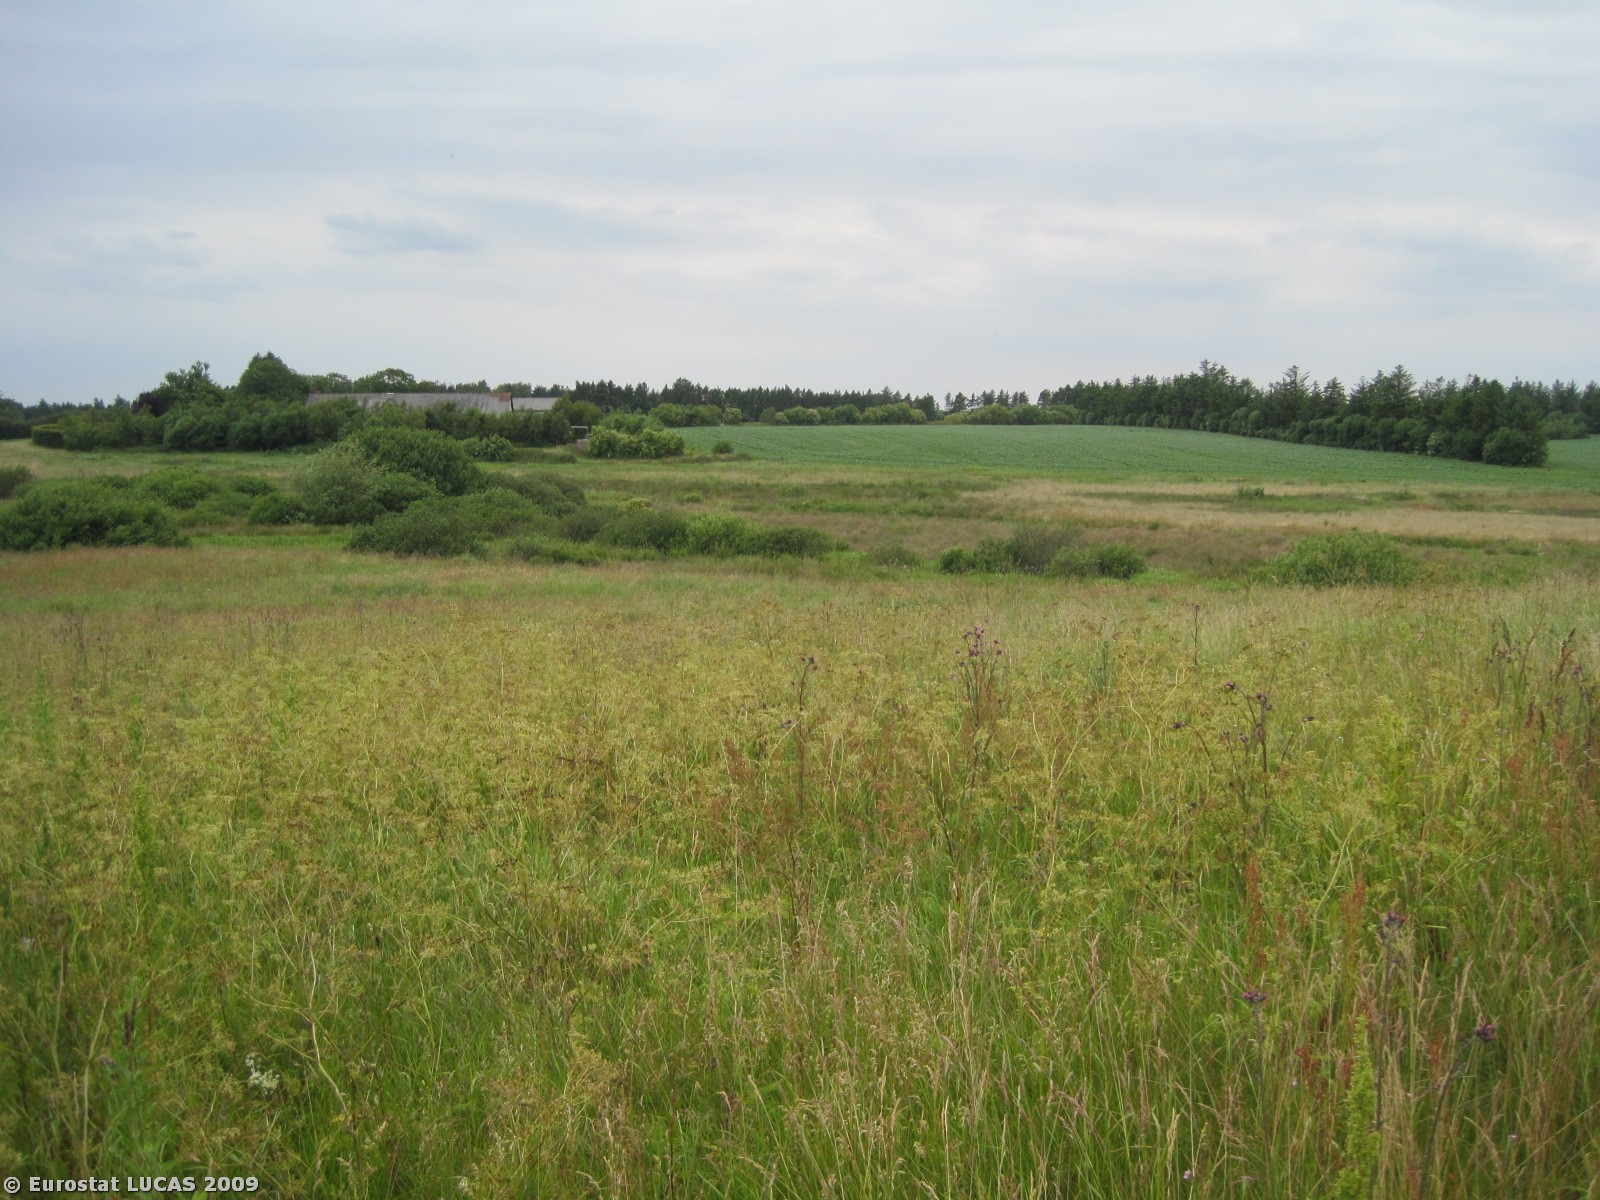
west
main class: Grassland
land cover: Grassland without tree/shrub cover
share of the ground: > 75 %
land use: Unused
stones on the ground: < 10 %
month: June
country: DK
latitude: 56.3411
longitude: 8.5296
